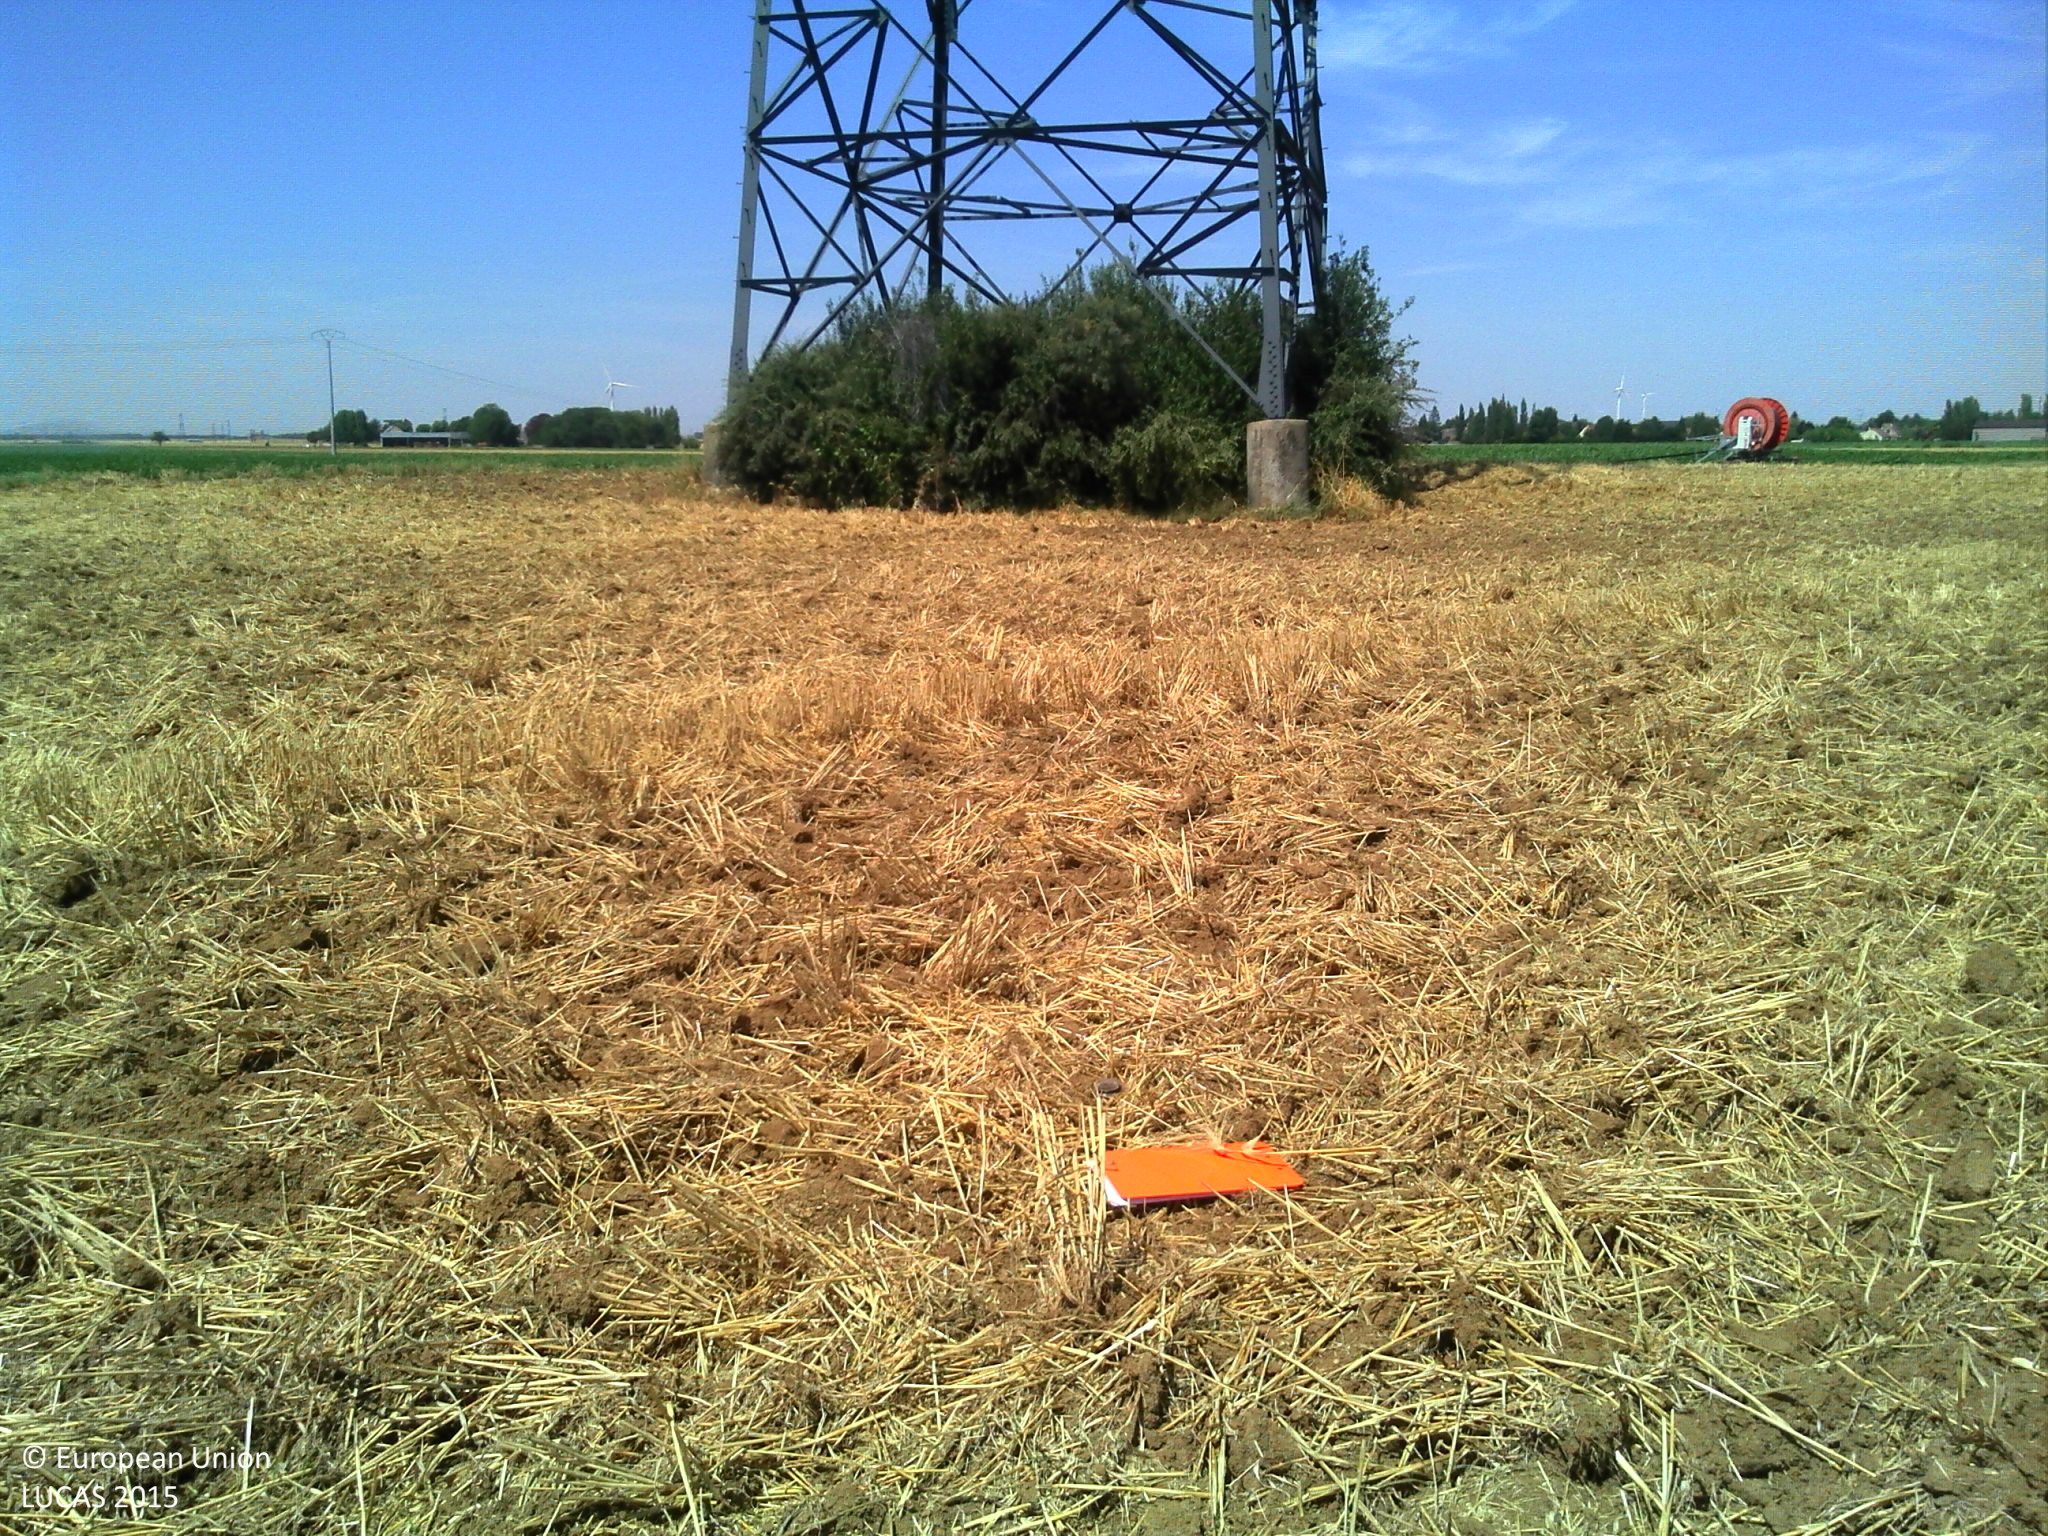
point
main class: Cropland
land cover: Triticale
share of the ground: > 75 %
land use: Agriculture (excluding fallow land and kitchen gardens)
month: August
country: FR
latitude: 48.1448
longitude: 1.9363
